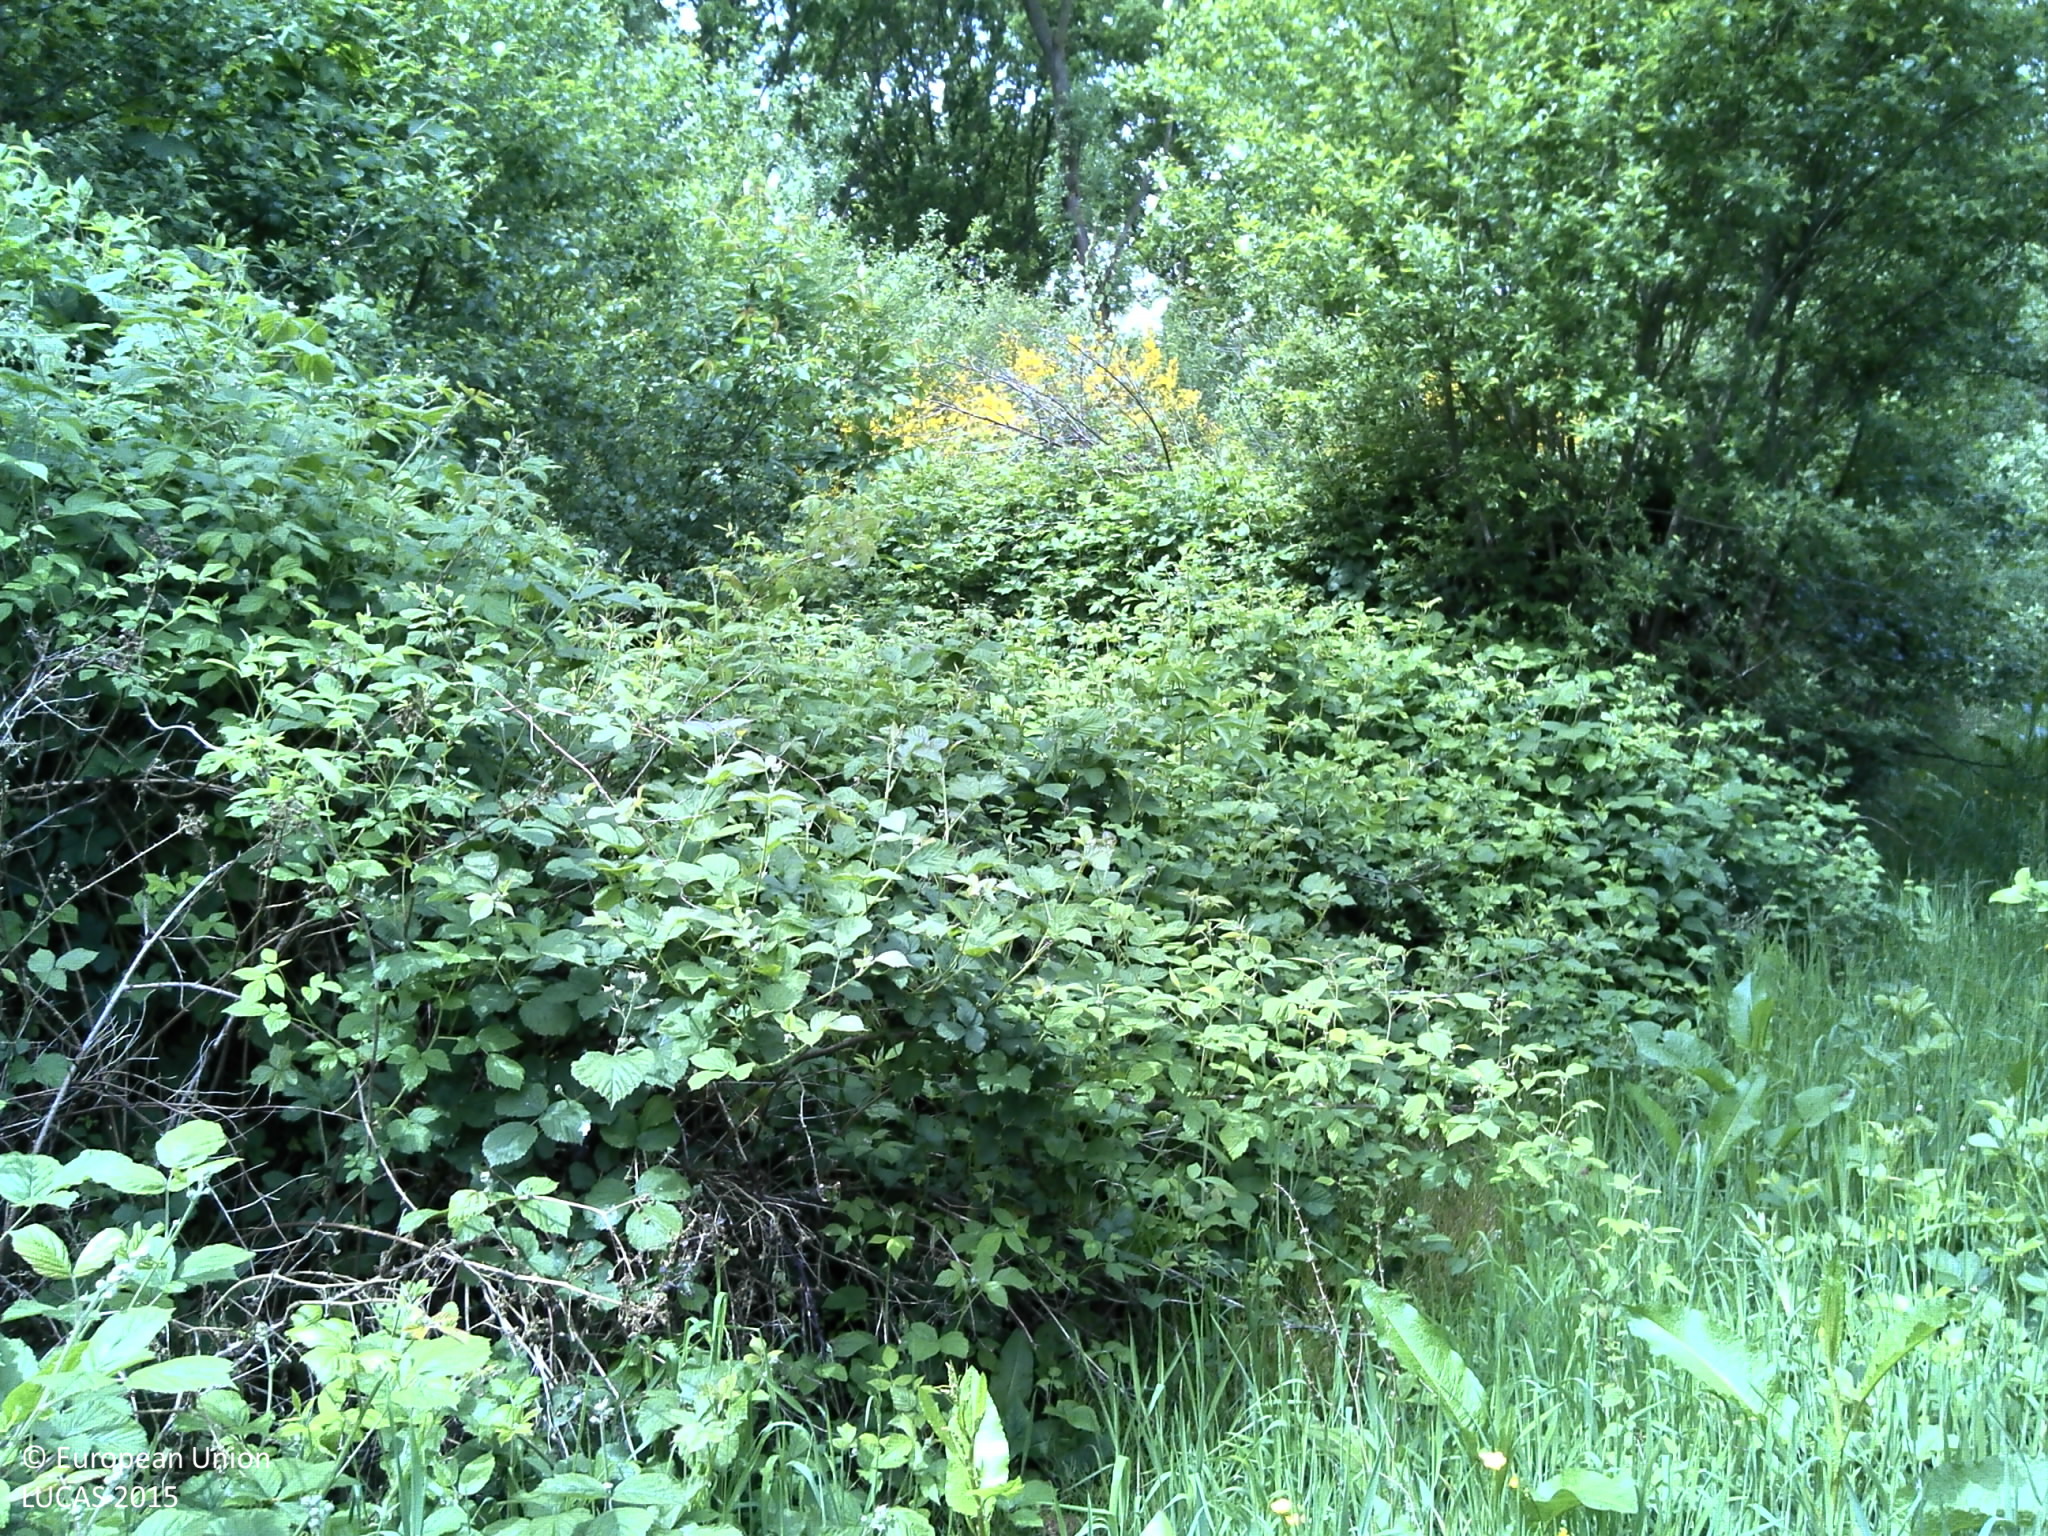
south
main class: Cropland
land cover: Rape and turnip rape
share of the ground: > 75 %
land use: Agriculture (excluding fallow land and kitchen gardens)
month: May
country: FR
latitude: 49.5541
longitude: 1.2015
